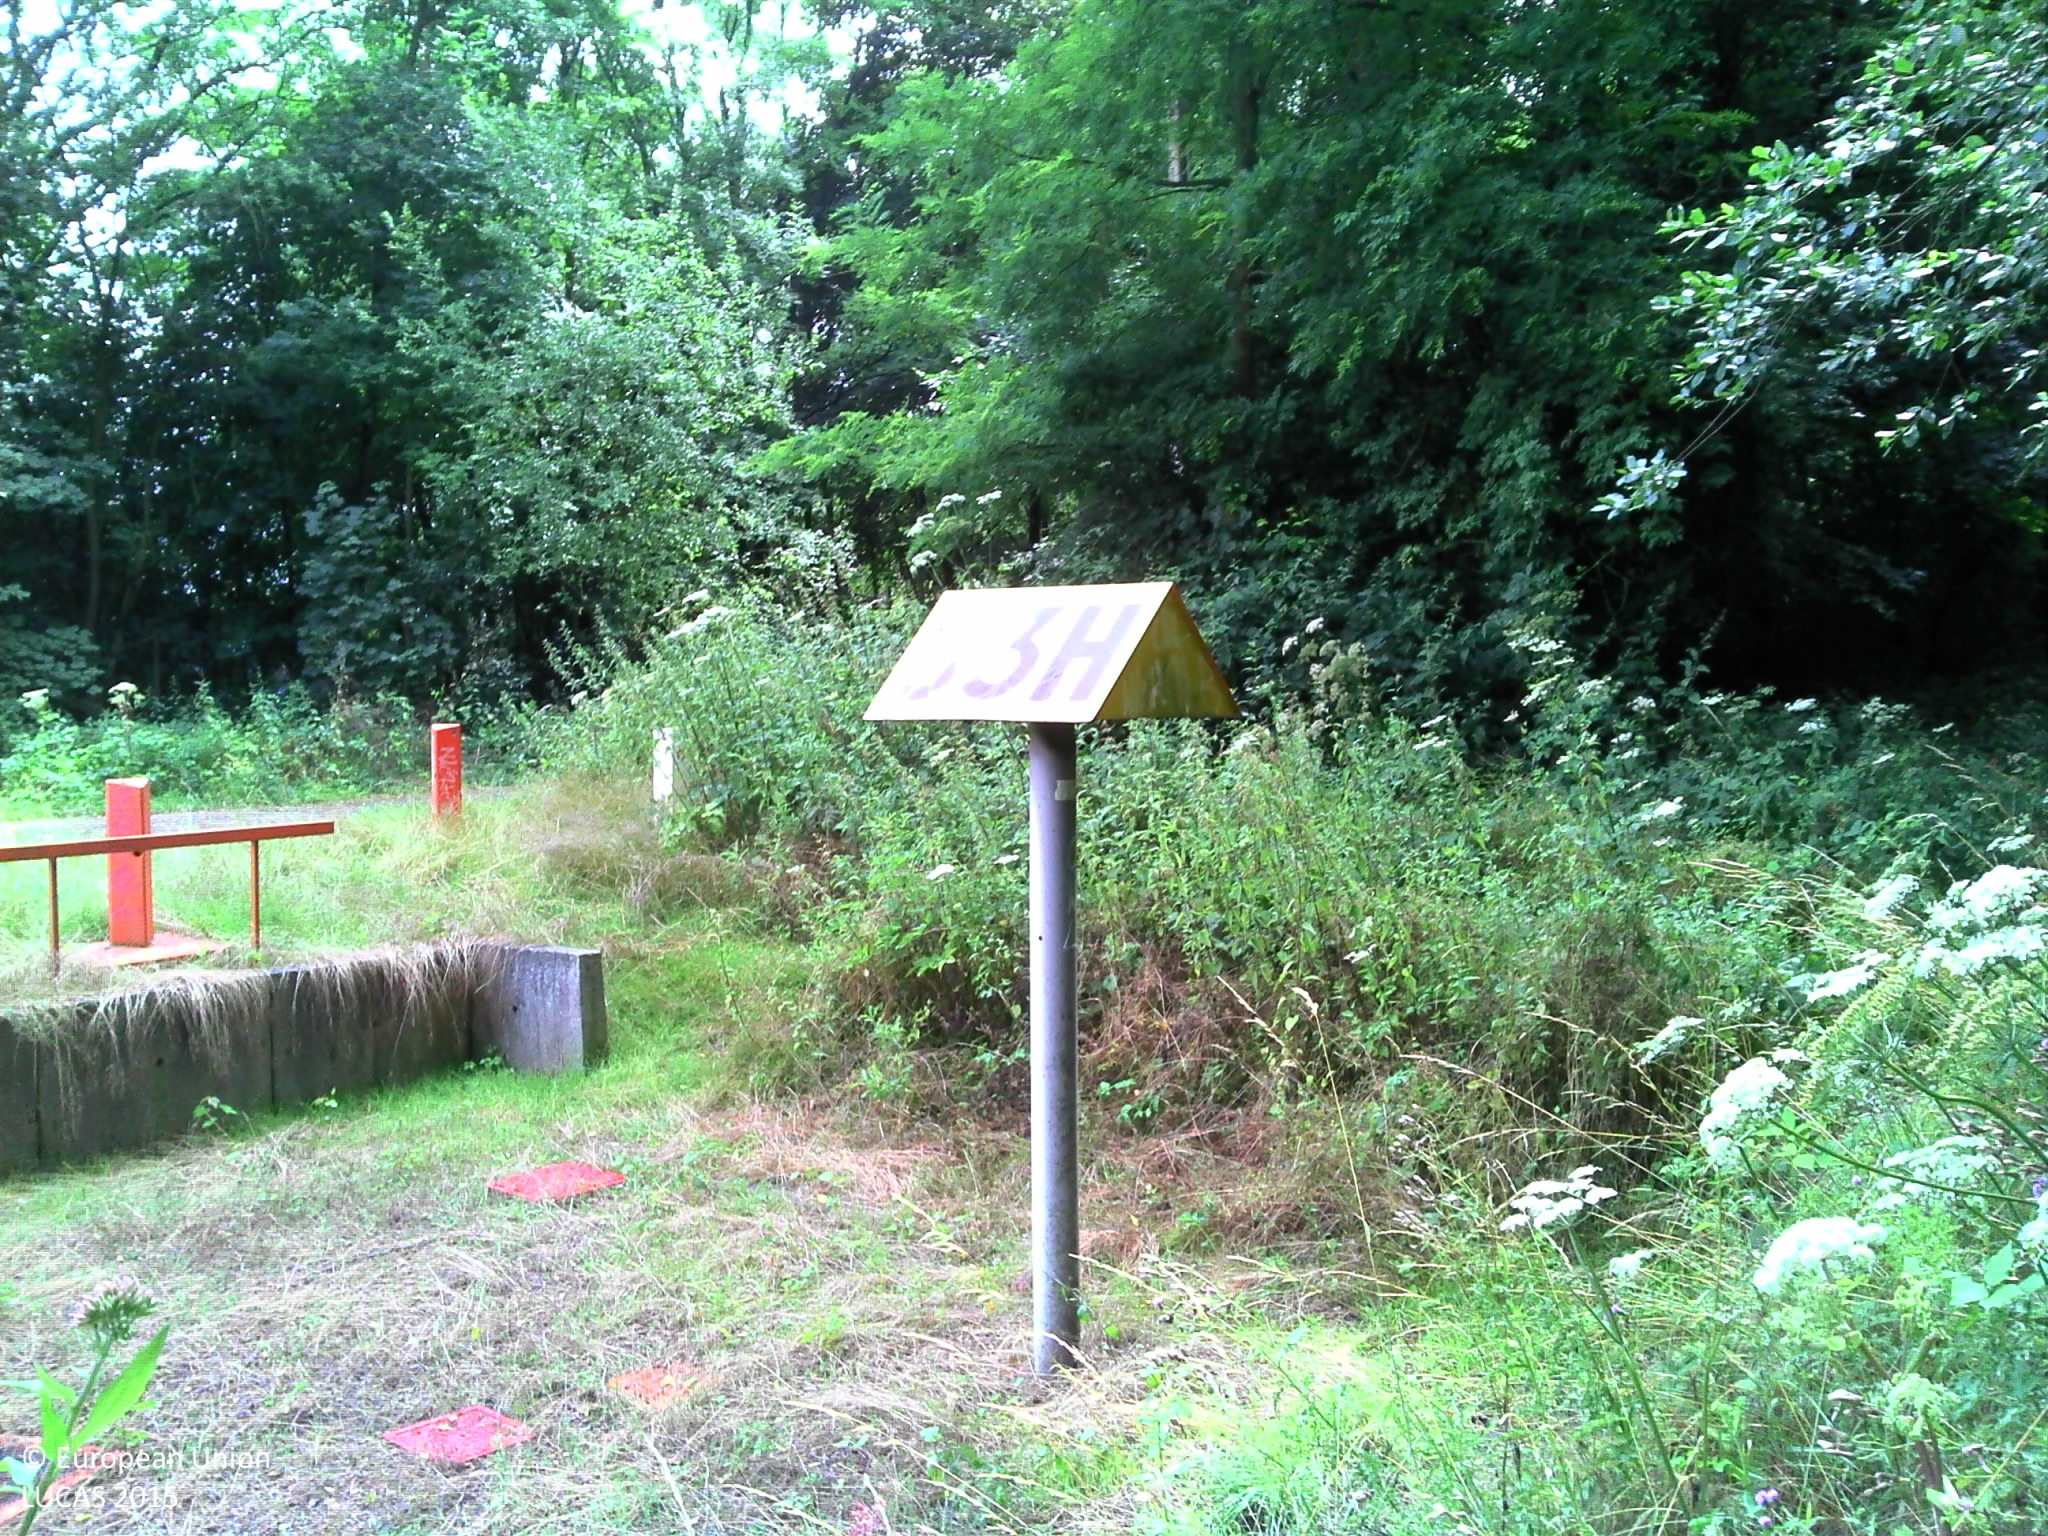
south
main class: Woodland
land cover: Spruce dominated mixed woodland
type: exotic forest
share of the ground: > 75 %
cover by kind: broadleaved forest trees 50 %, shrubs 25 %, coniferous forest trees 20 %, herbaceous plants 5 %
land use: Forestry
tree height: > 5 m
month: July
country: BE
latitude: 50.4489
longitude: 4.5176
